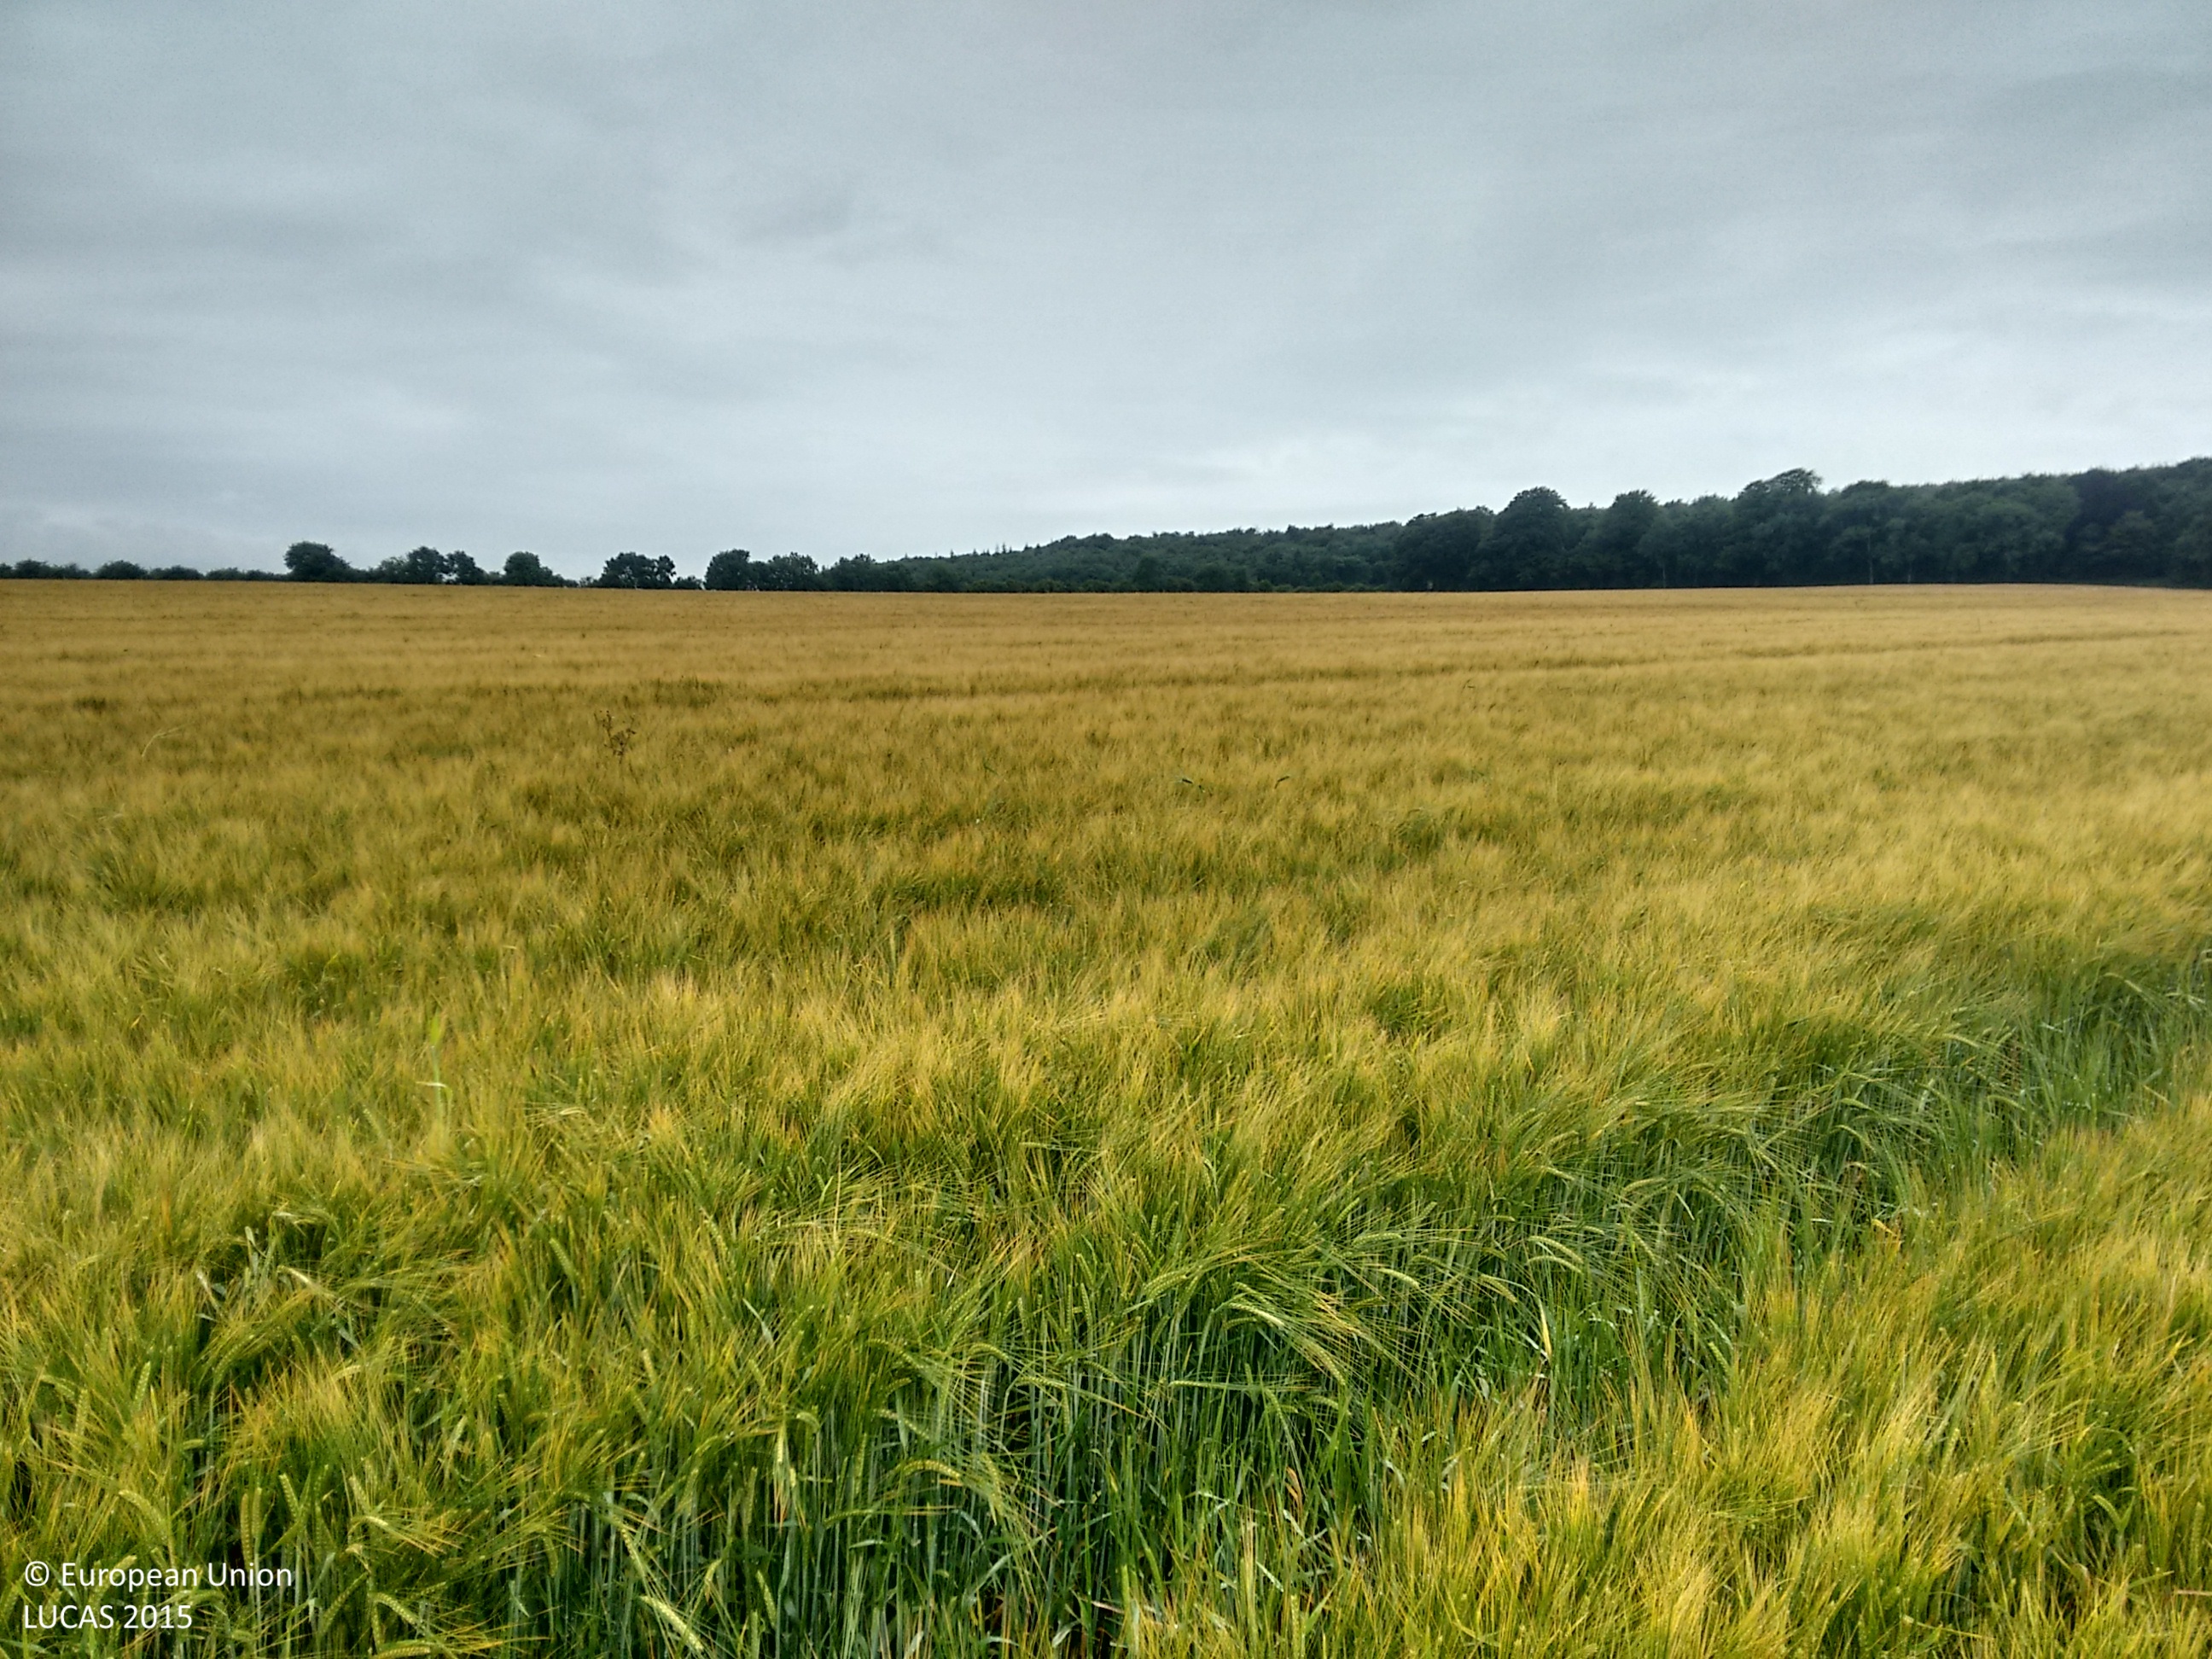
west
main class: Cropland
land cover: Barley
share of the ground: > 75 %
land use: Agriculture (excluding fallow land and kitchen gardens)
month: July
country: IE
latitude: 52.5035
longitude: -7.2244
